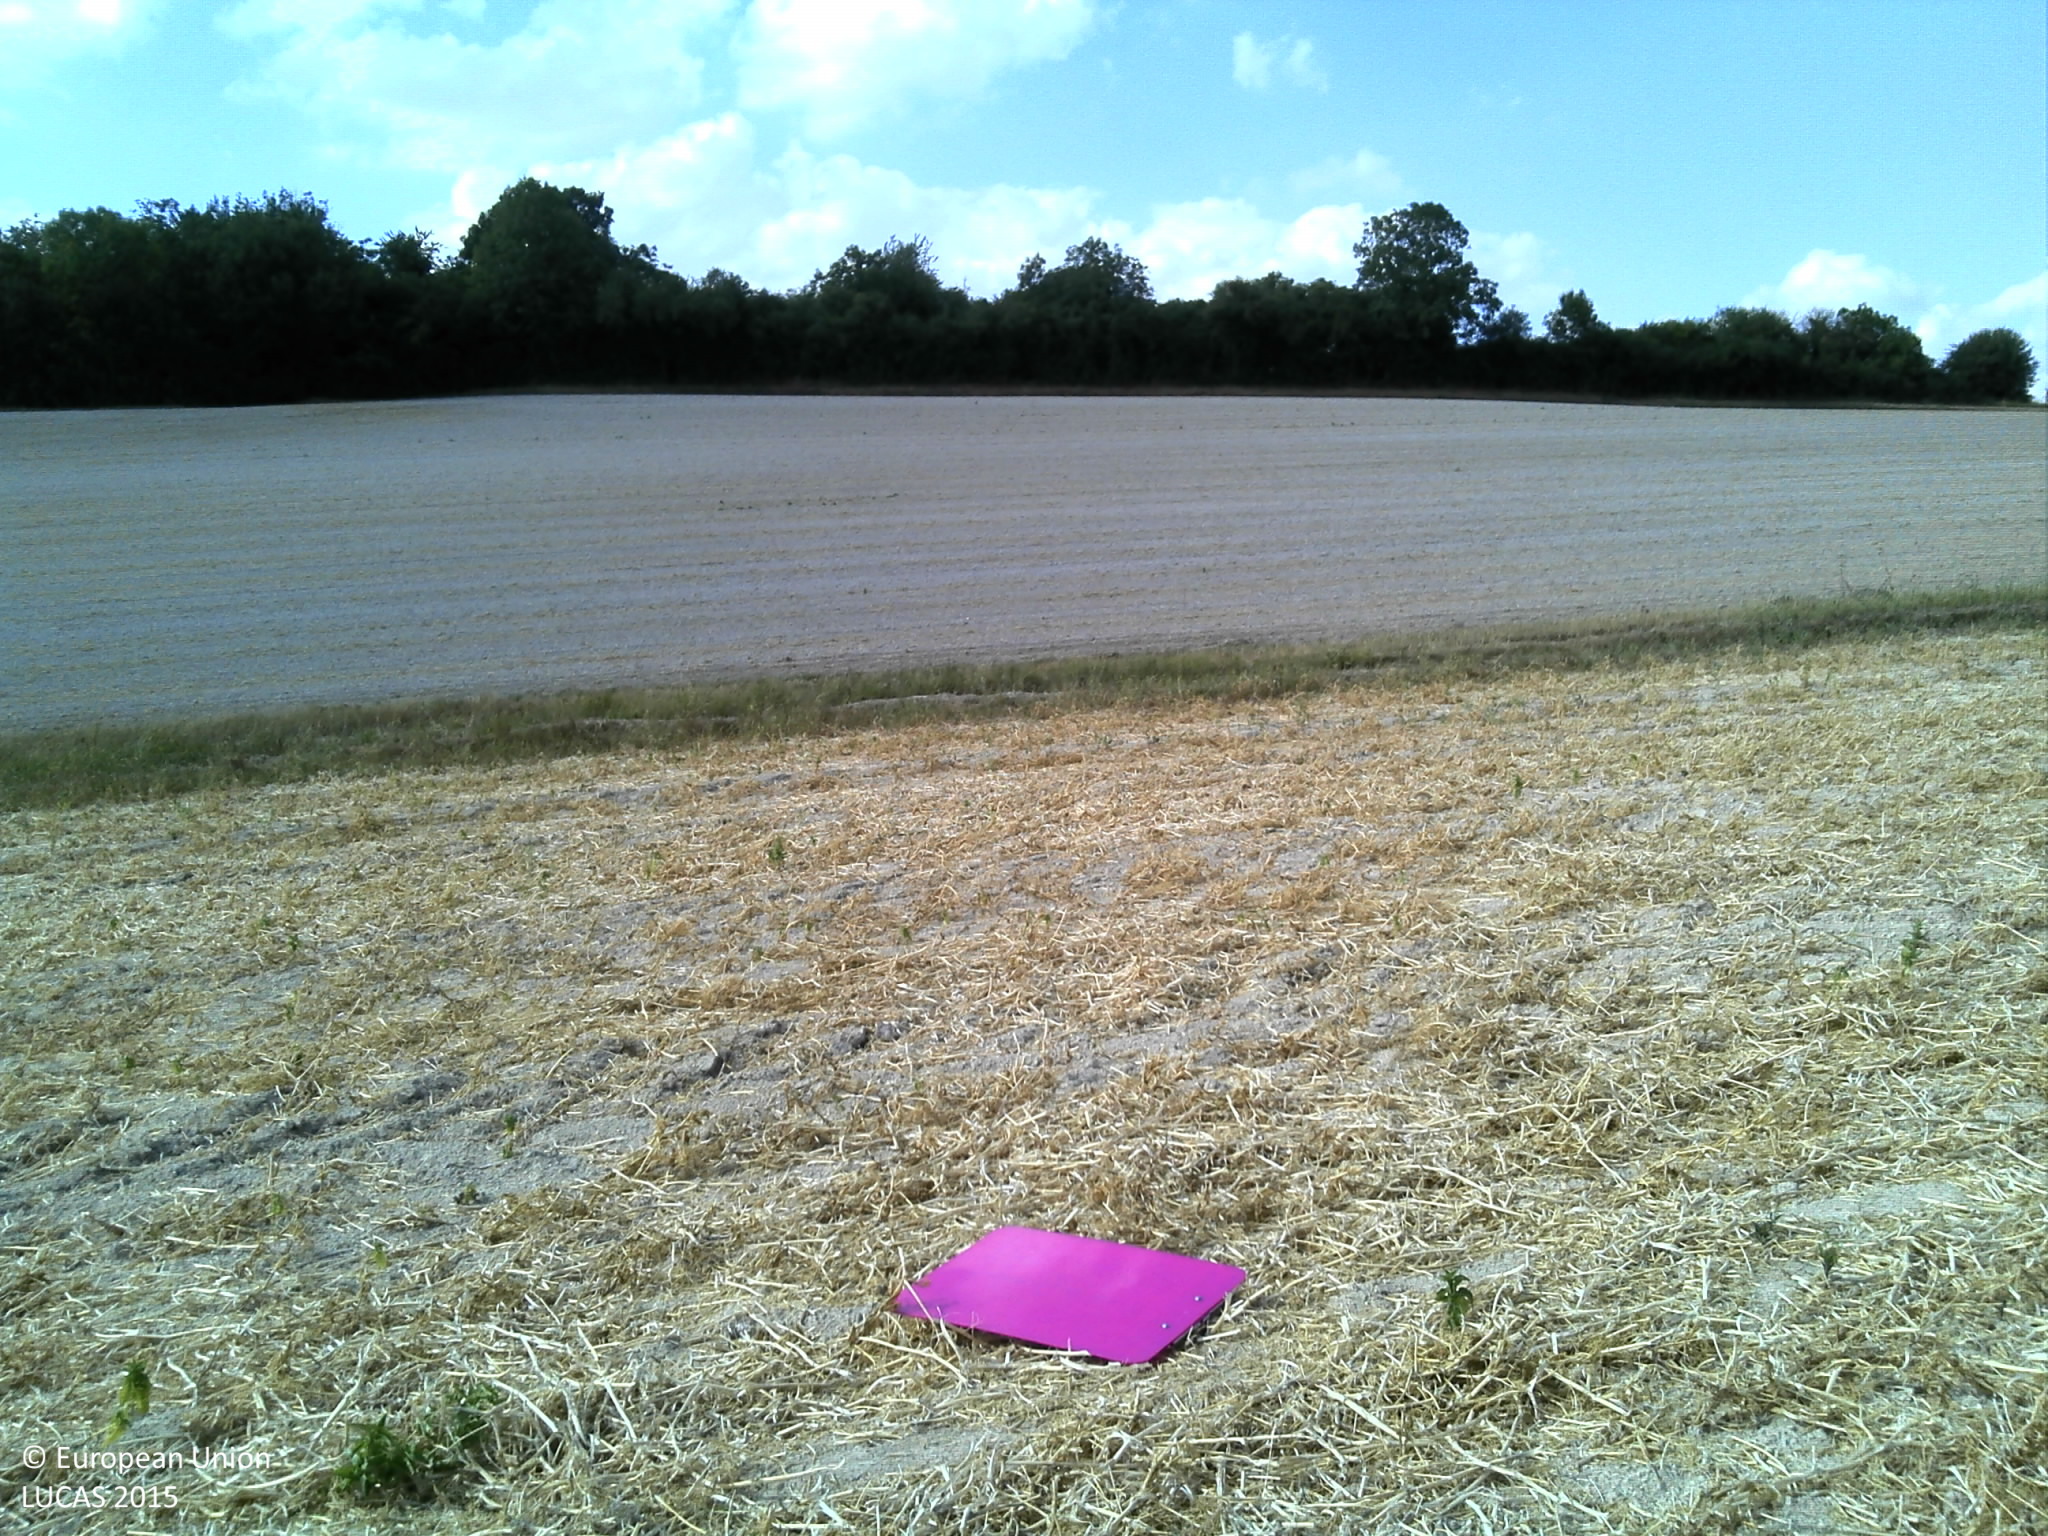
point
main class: Cropland
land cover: Dry pulses
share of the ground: > 75 %
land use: Agriculture (excluding fallow land and kitchen gardens)
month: August
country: FR
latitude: 48.7762
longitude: 4.5948
